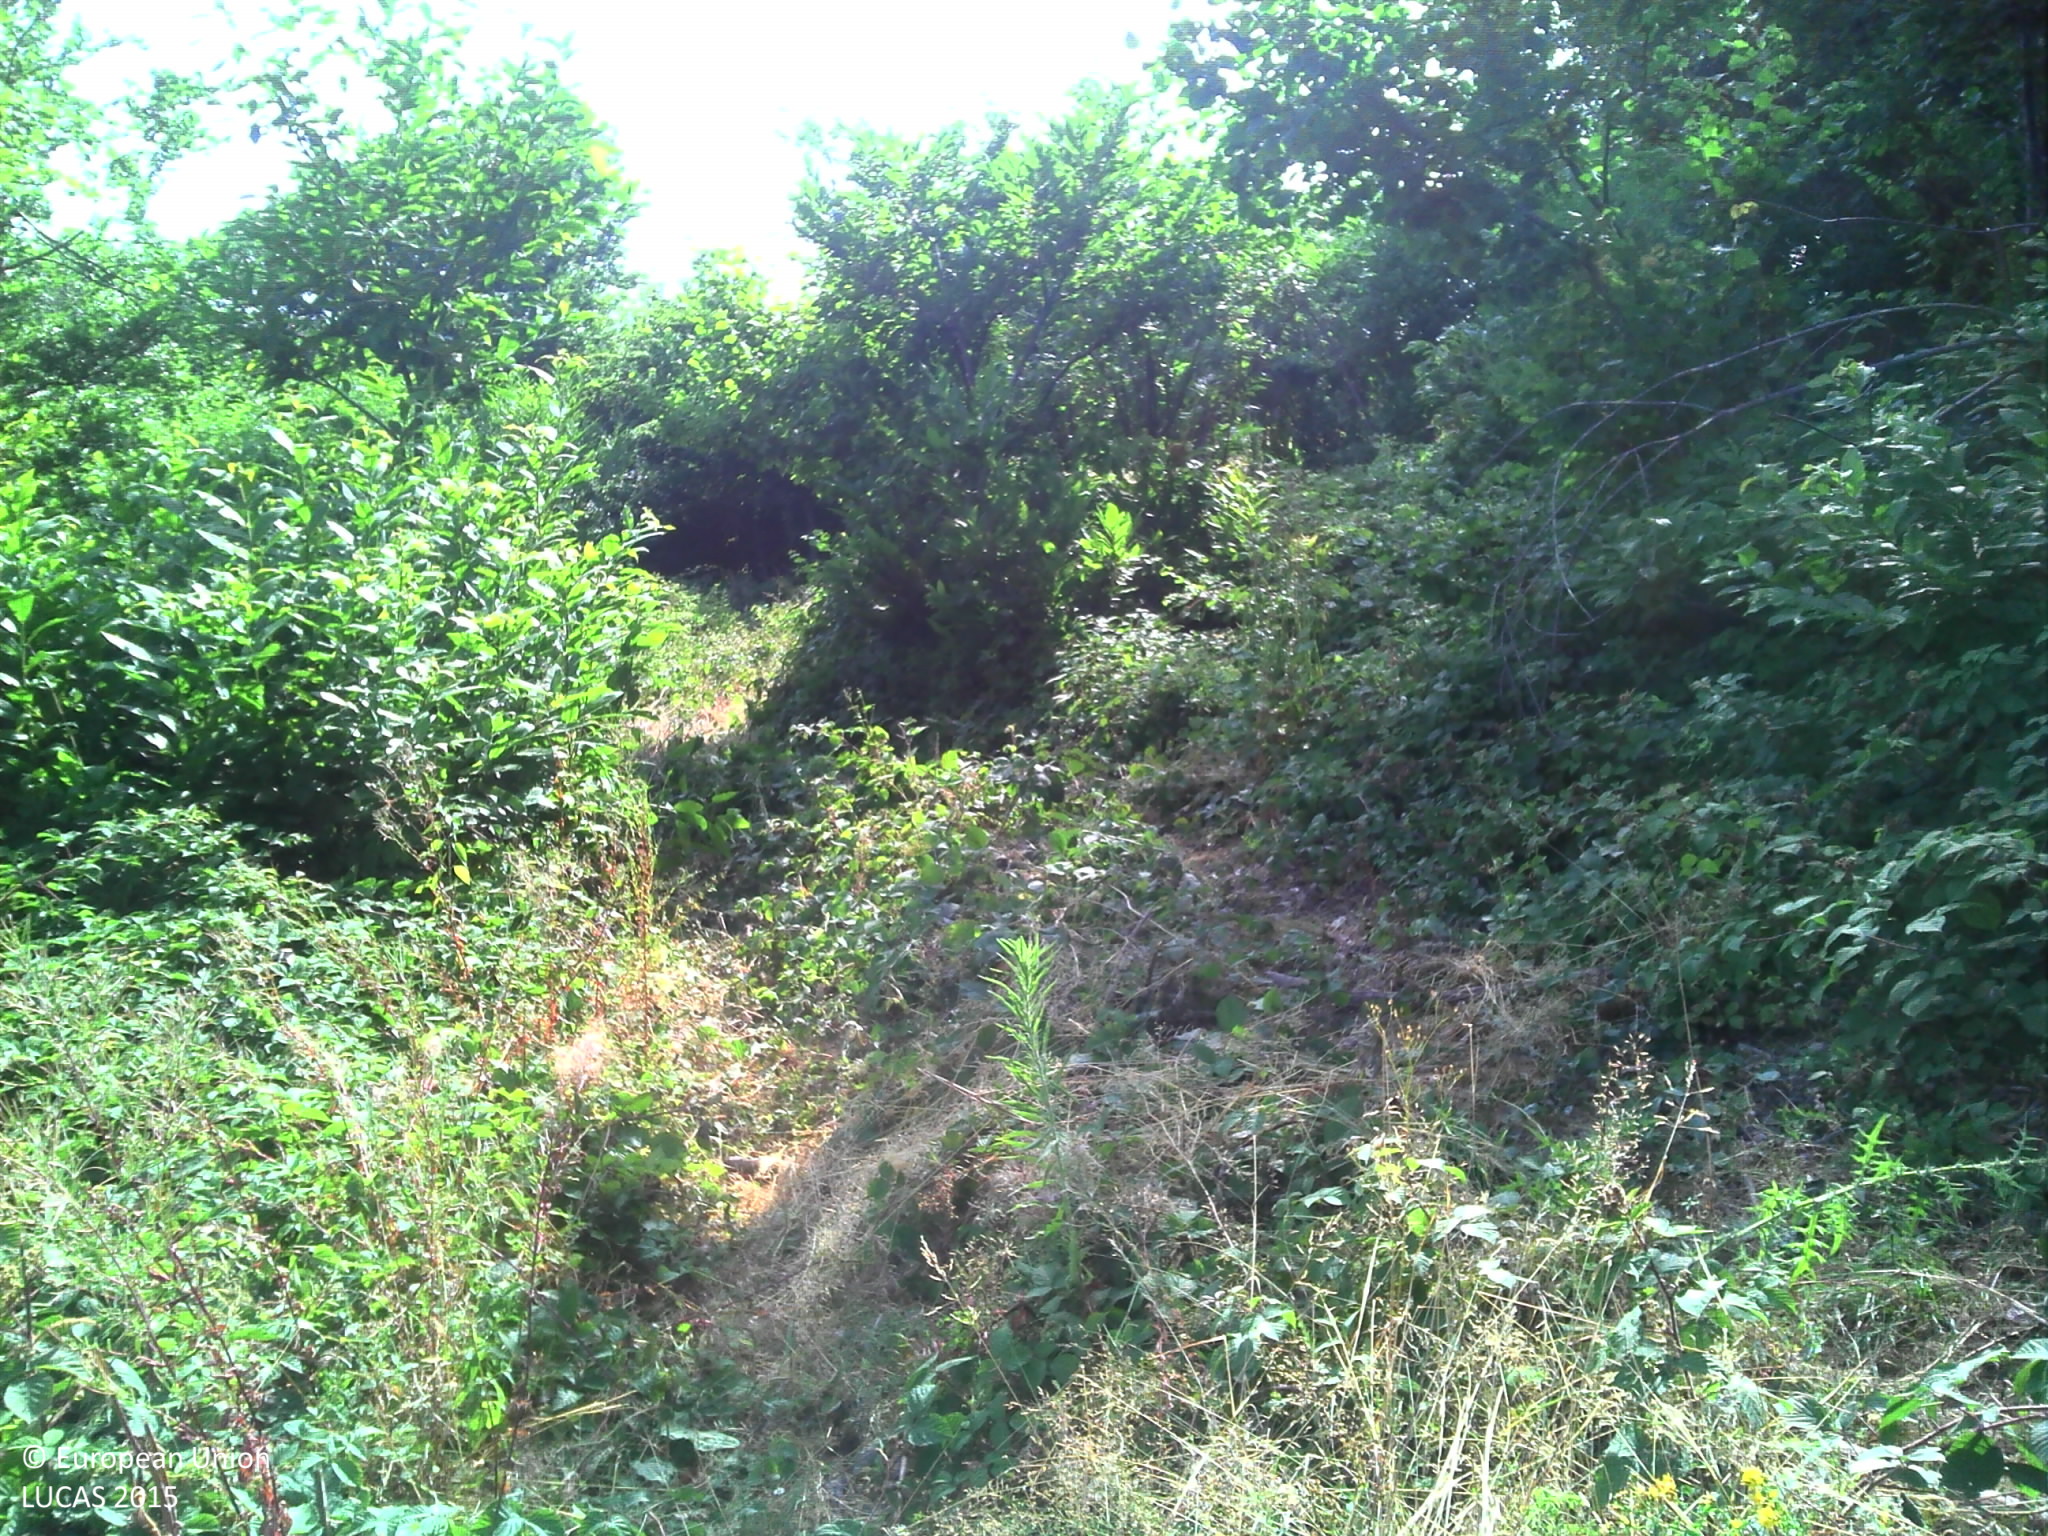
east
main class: Woodland
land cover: Broadleaved woodland
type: floodplain forest
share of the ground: > 75 %
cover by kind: broadleaved forest trees 50 %, herbaceous plants 50 %
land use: Forestry
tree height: > 5 m
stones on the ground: 10 - 25 %
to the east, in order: Shrubland without tree cover; Broadleaved woodland; Grassland without tree/shrub cover; Electric lines; Grassland without tree/shrub cover; Fences; Grassland without tree/shrub cover; Fences; Grassland without tree/shrub cover; Fences; Broadleaved woodland; Common wheat; Electric lines; Common wheat
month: July
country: FR
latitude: 45.4960
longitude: 5.4362
